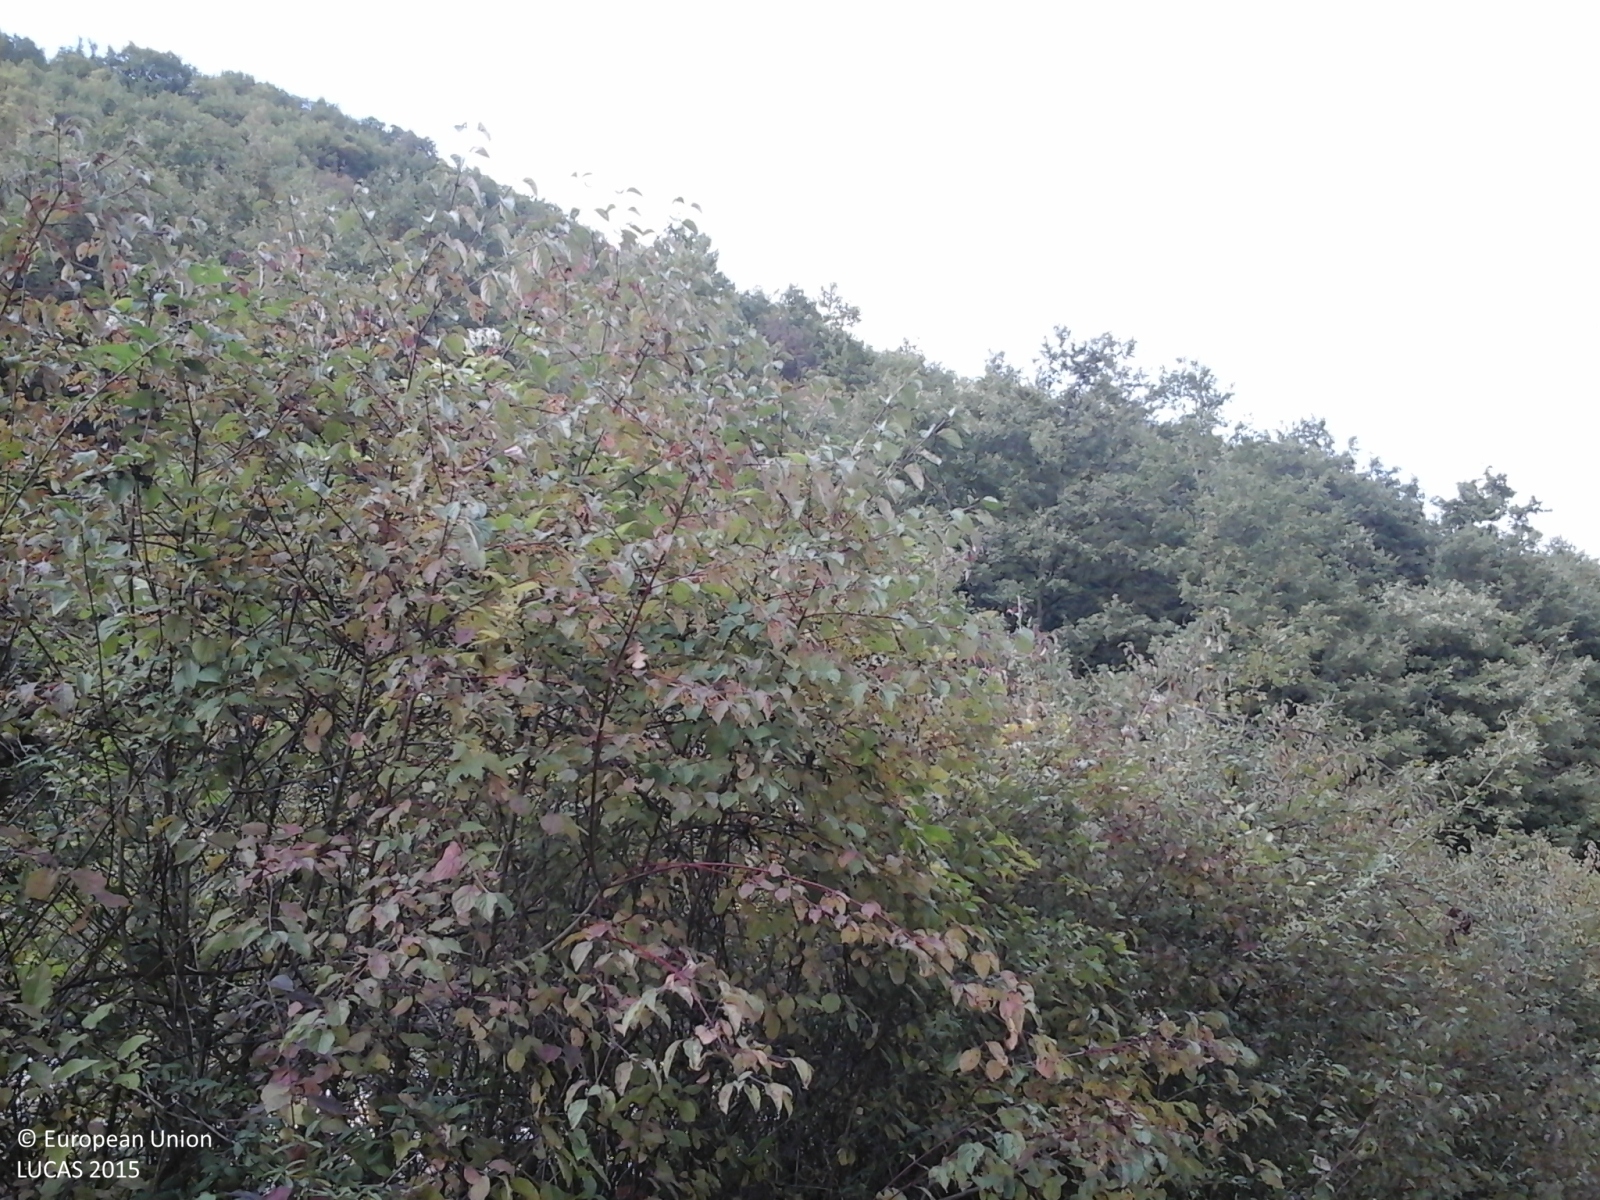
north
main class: Woodland
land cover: Broadleaved woodland
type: thermophilous deciduous forest
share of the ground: > 75 %
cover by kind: broadleaved forest trees 95 %, shrubs 5 %
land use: Forestry
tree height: > 5 m
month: October
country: IT
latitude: 43.1623
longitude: 12.6123
